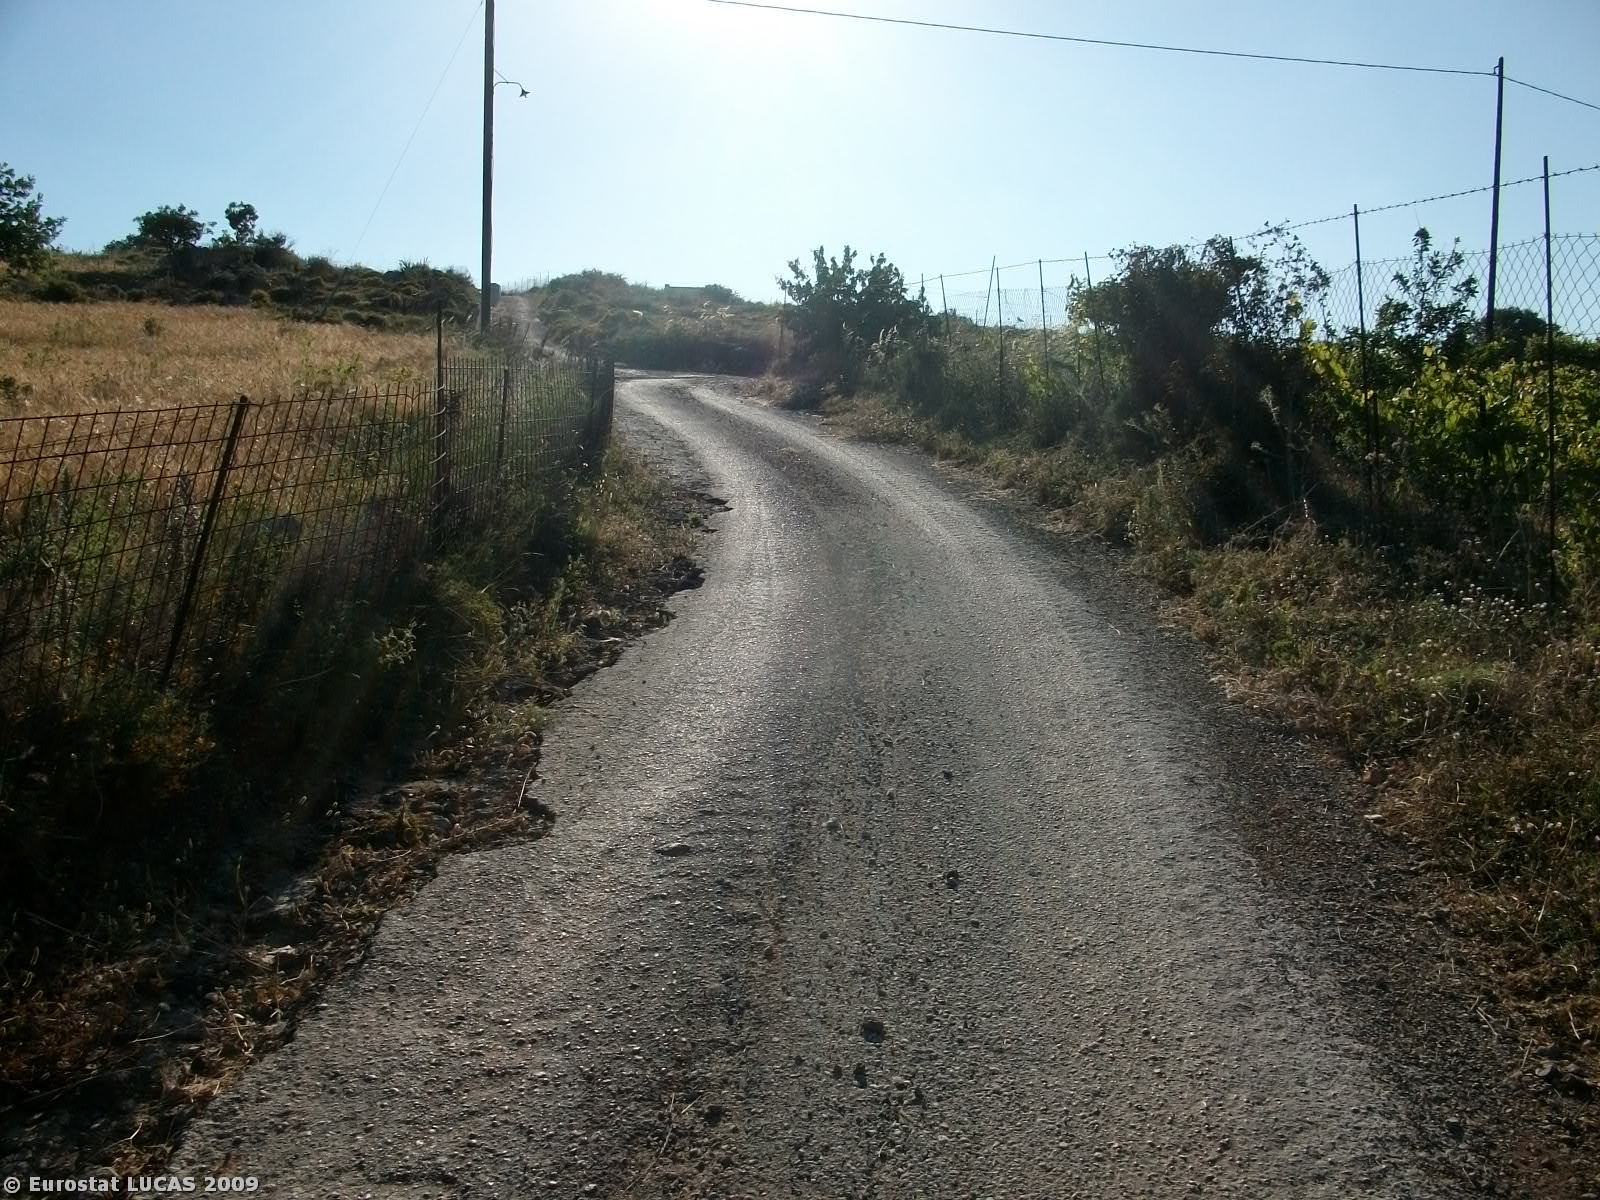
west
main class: Cropland
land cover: Olive groves
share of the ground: > 75 %
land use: Agriculture (excluding fallow land and kitchen gardens)
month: June
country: GR
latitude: 35.3303
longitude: 24.4529
